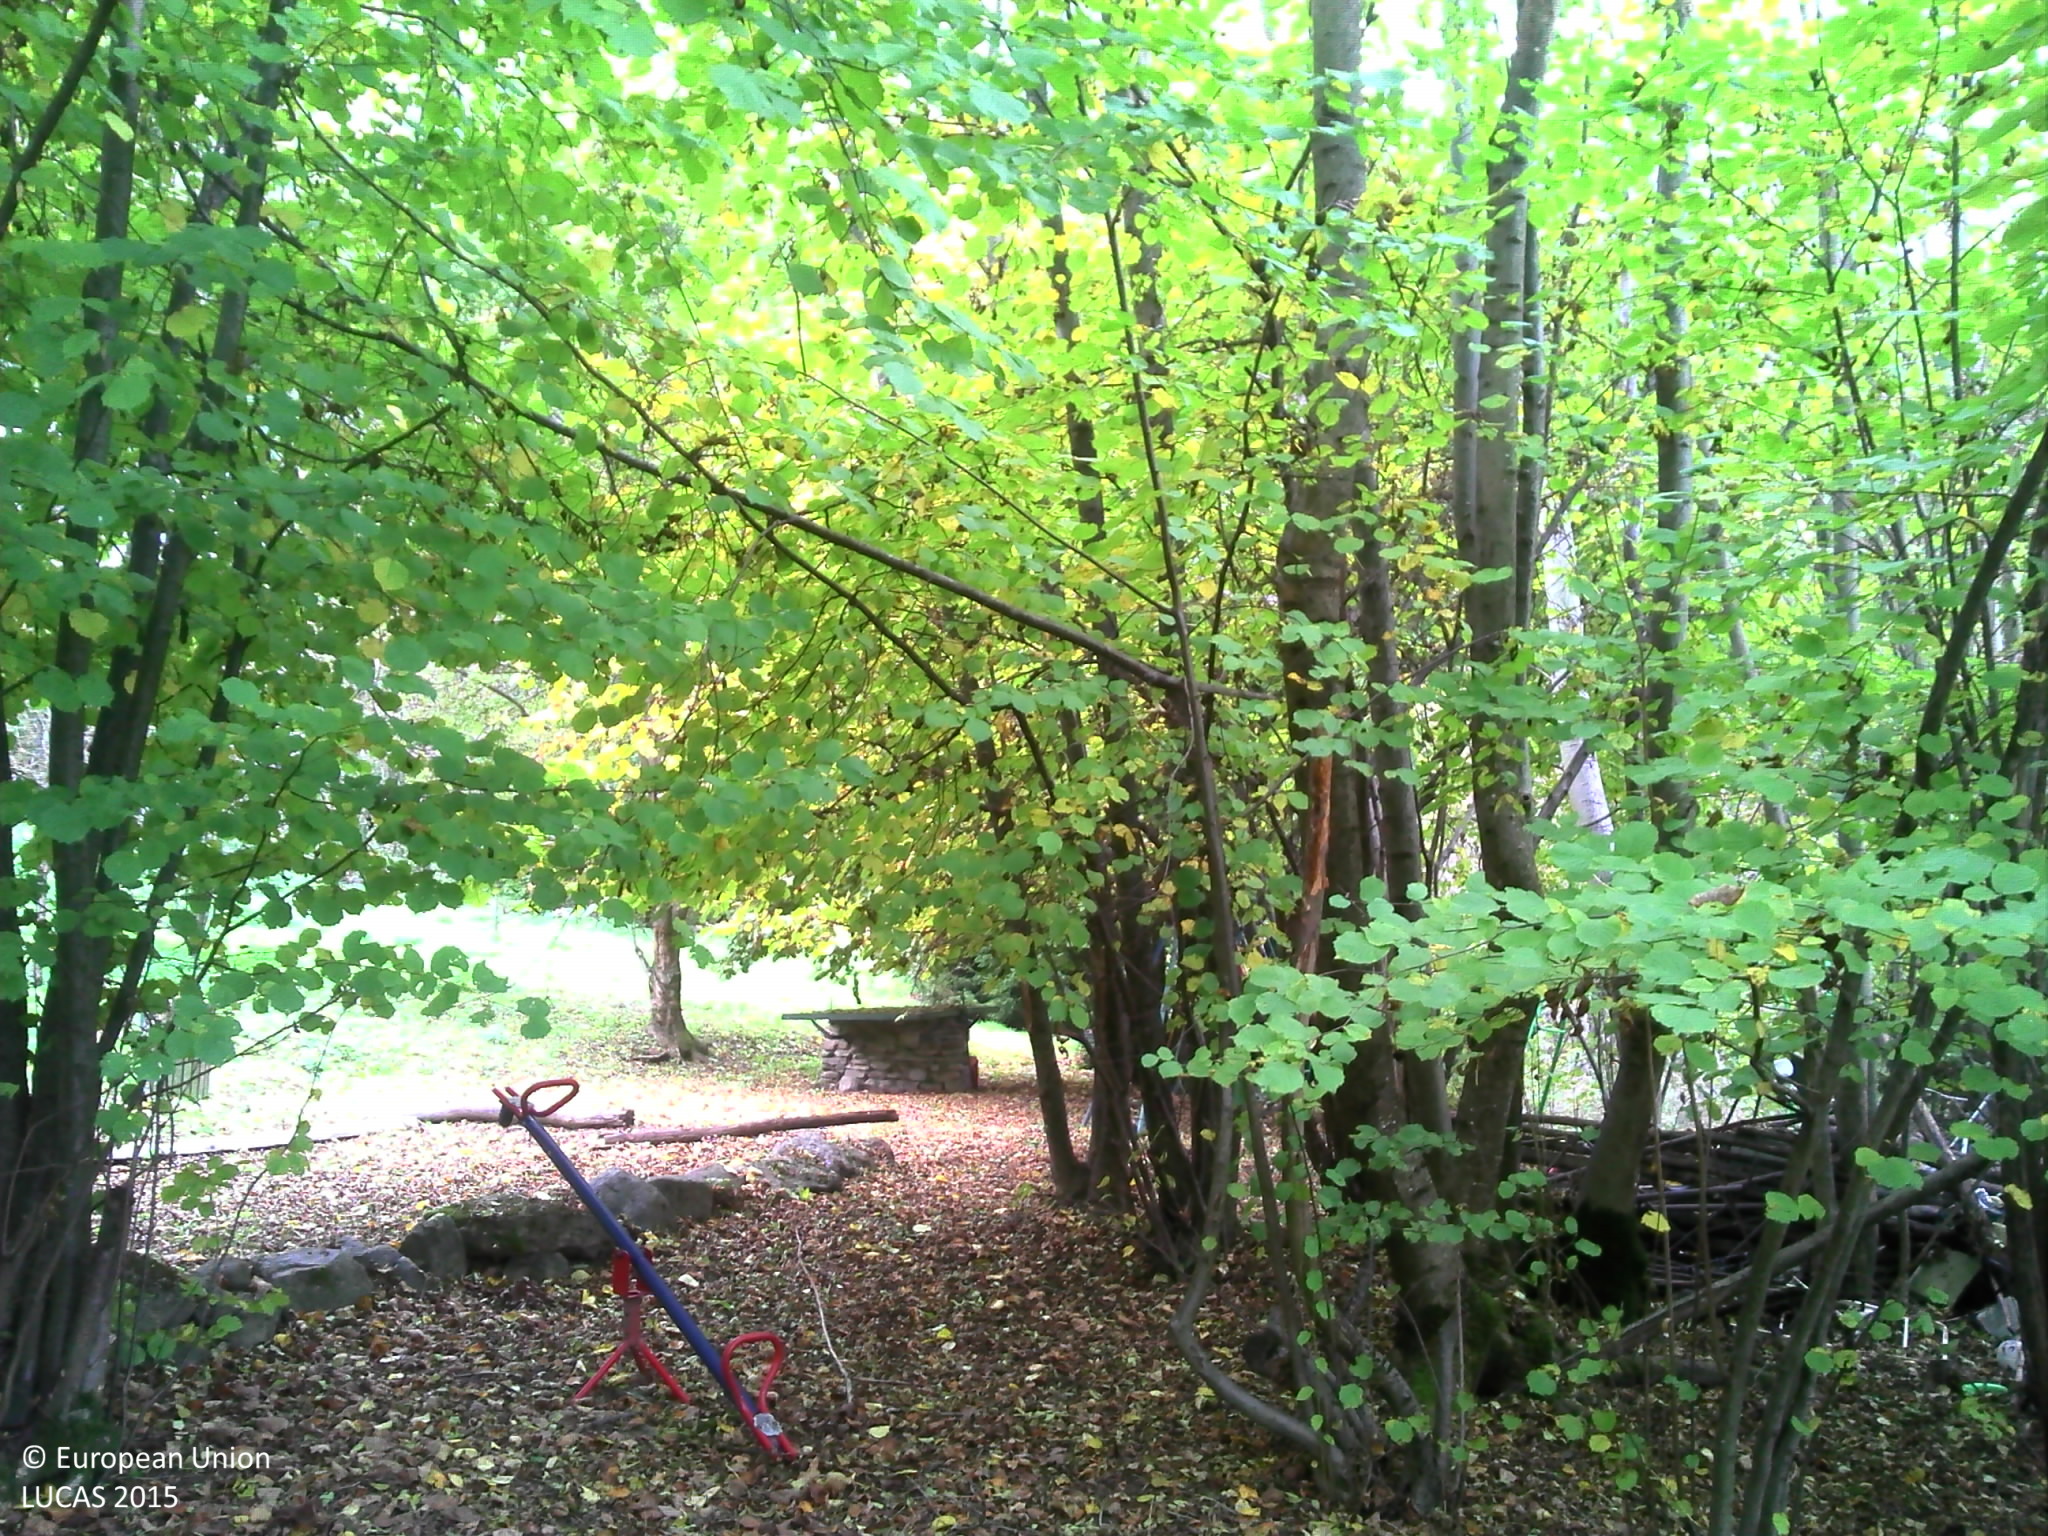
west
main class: Woodland
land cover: Broadleaved woodland
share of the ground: > 75 %
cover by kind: broadleaved forest trees 90 %, unconsolidated bare surface 10 %
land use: Residential
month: October
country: FR
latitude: 45.3842
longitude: 6.2628
